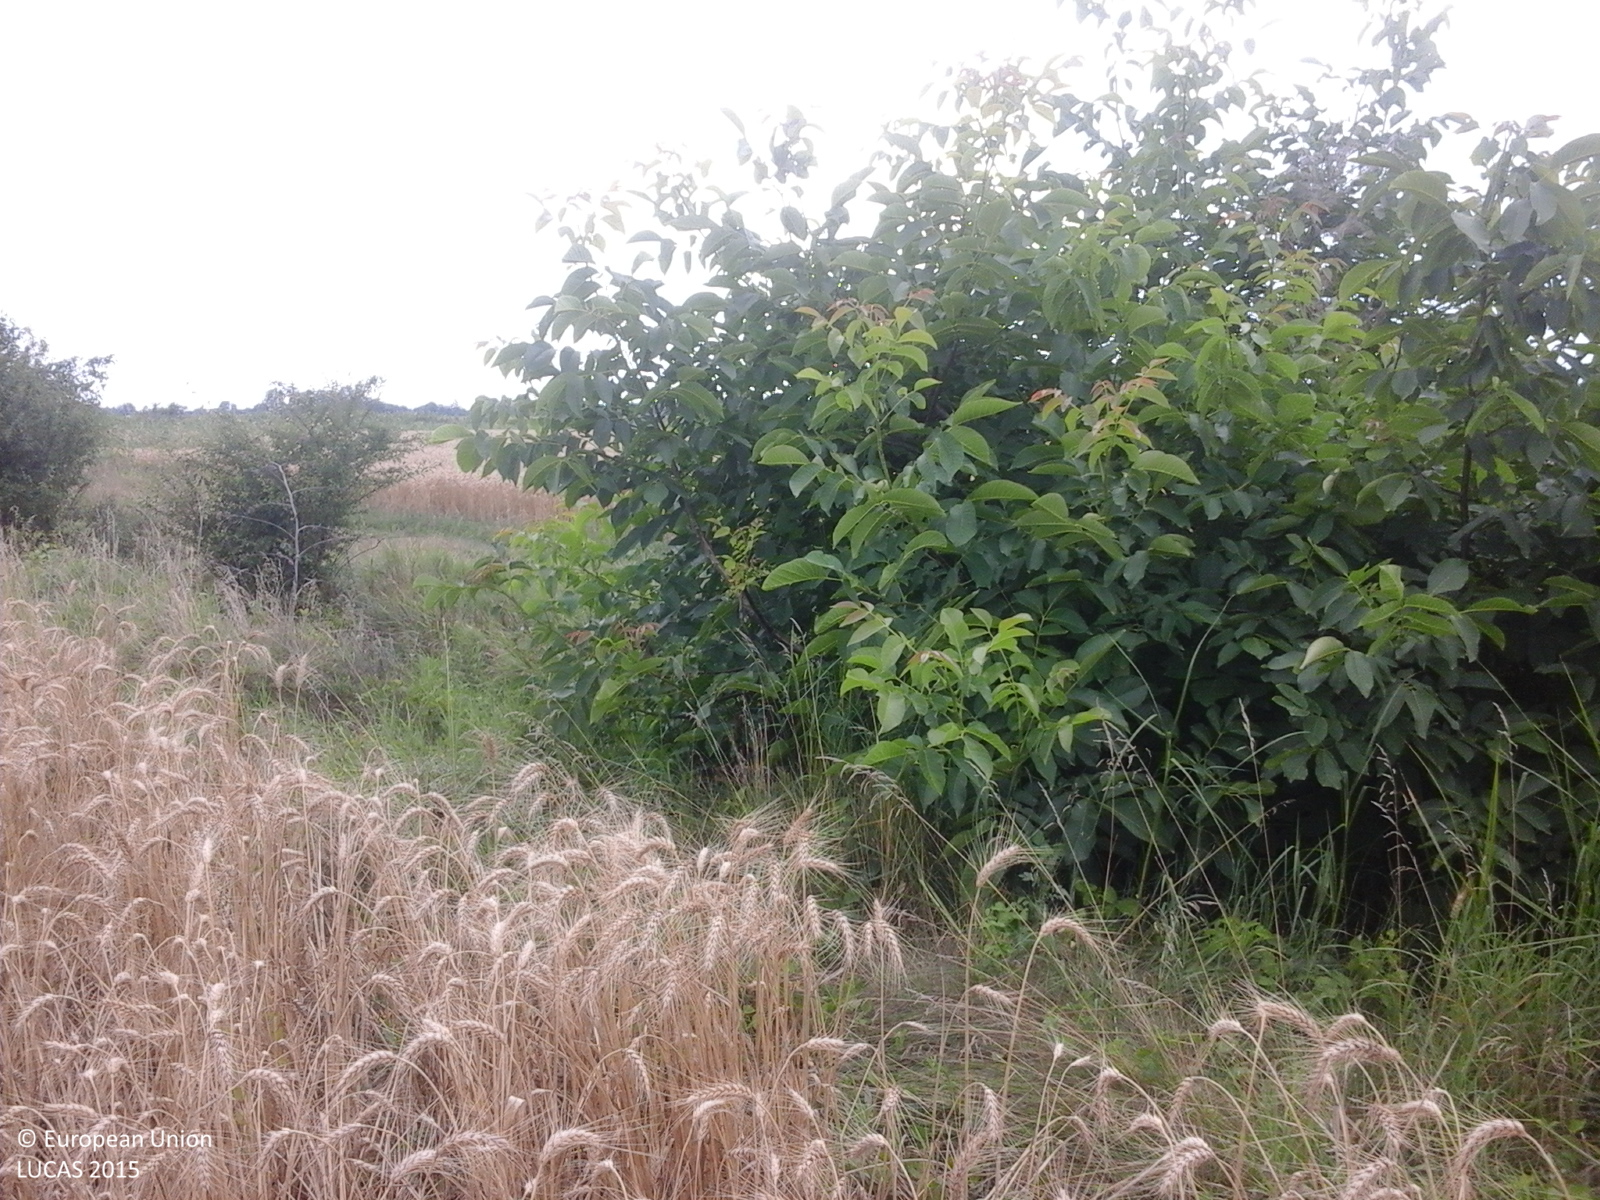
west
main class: Cropland
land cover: Common wheat
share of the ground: > 75 %
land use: Agriculture (excluding fallow land and kitchen gardens)
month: June
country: RO
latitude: 44.1240
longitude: 26.5976
